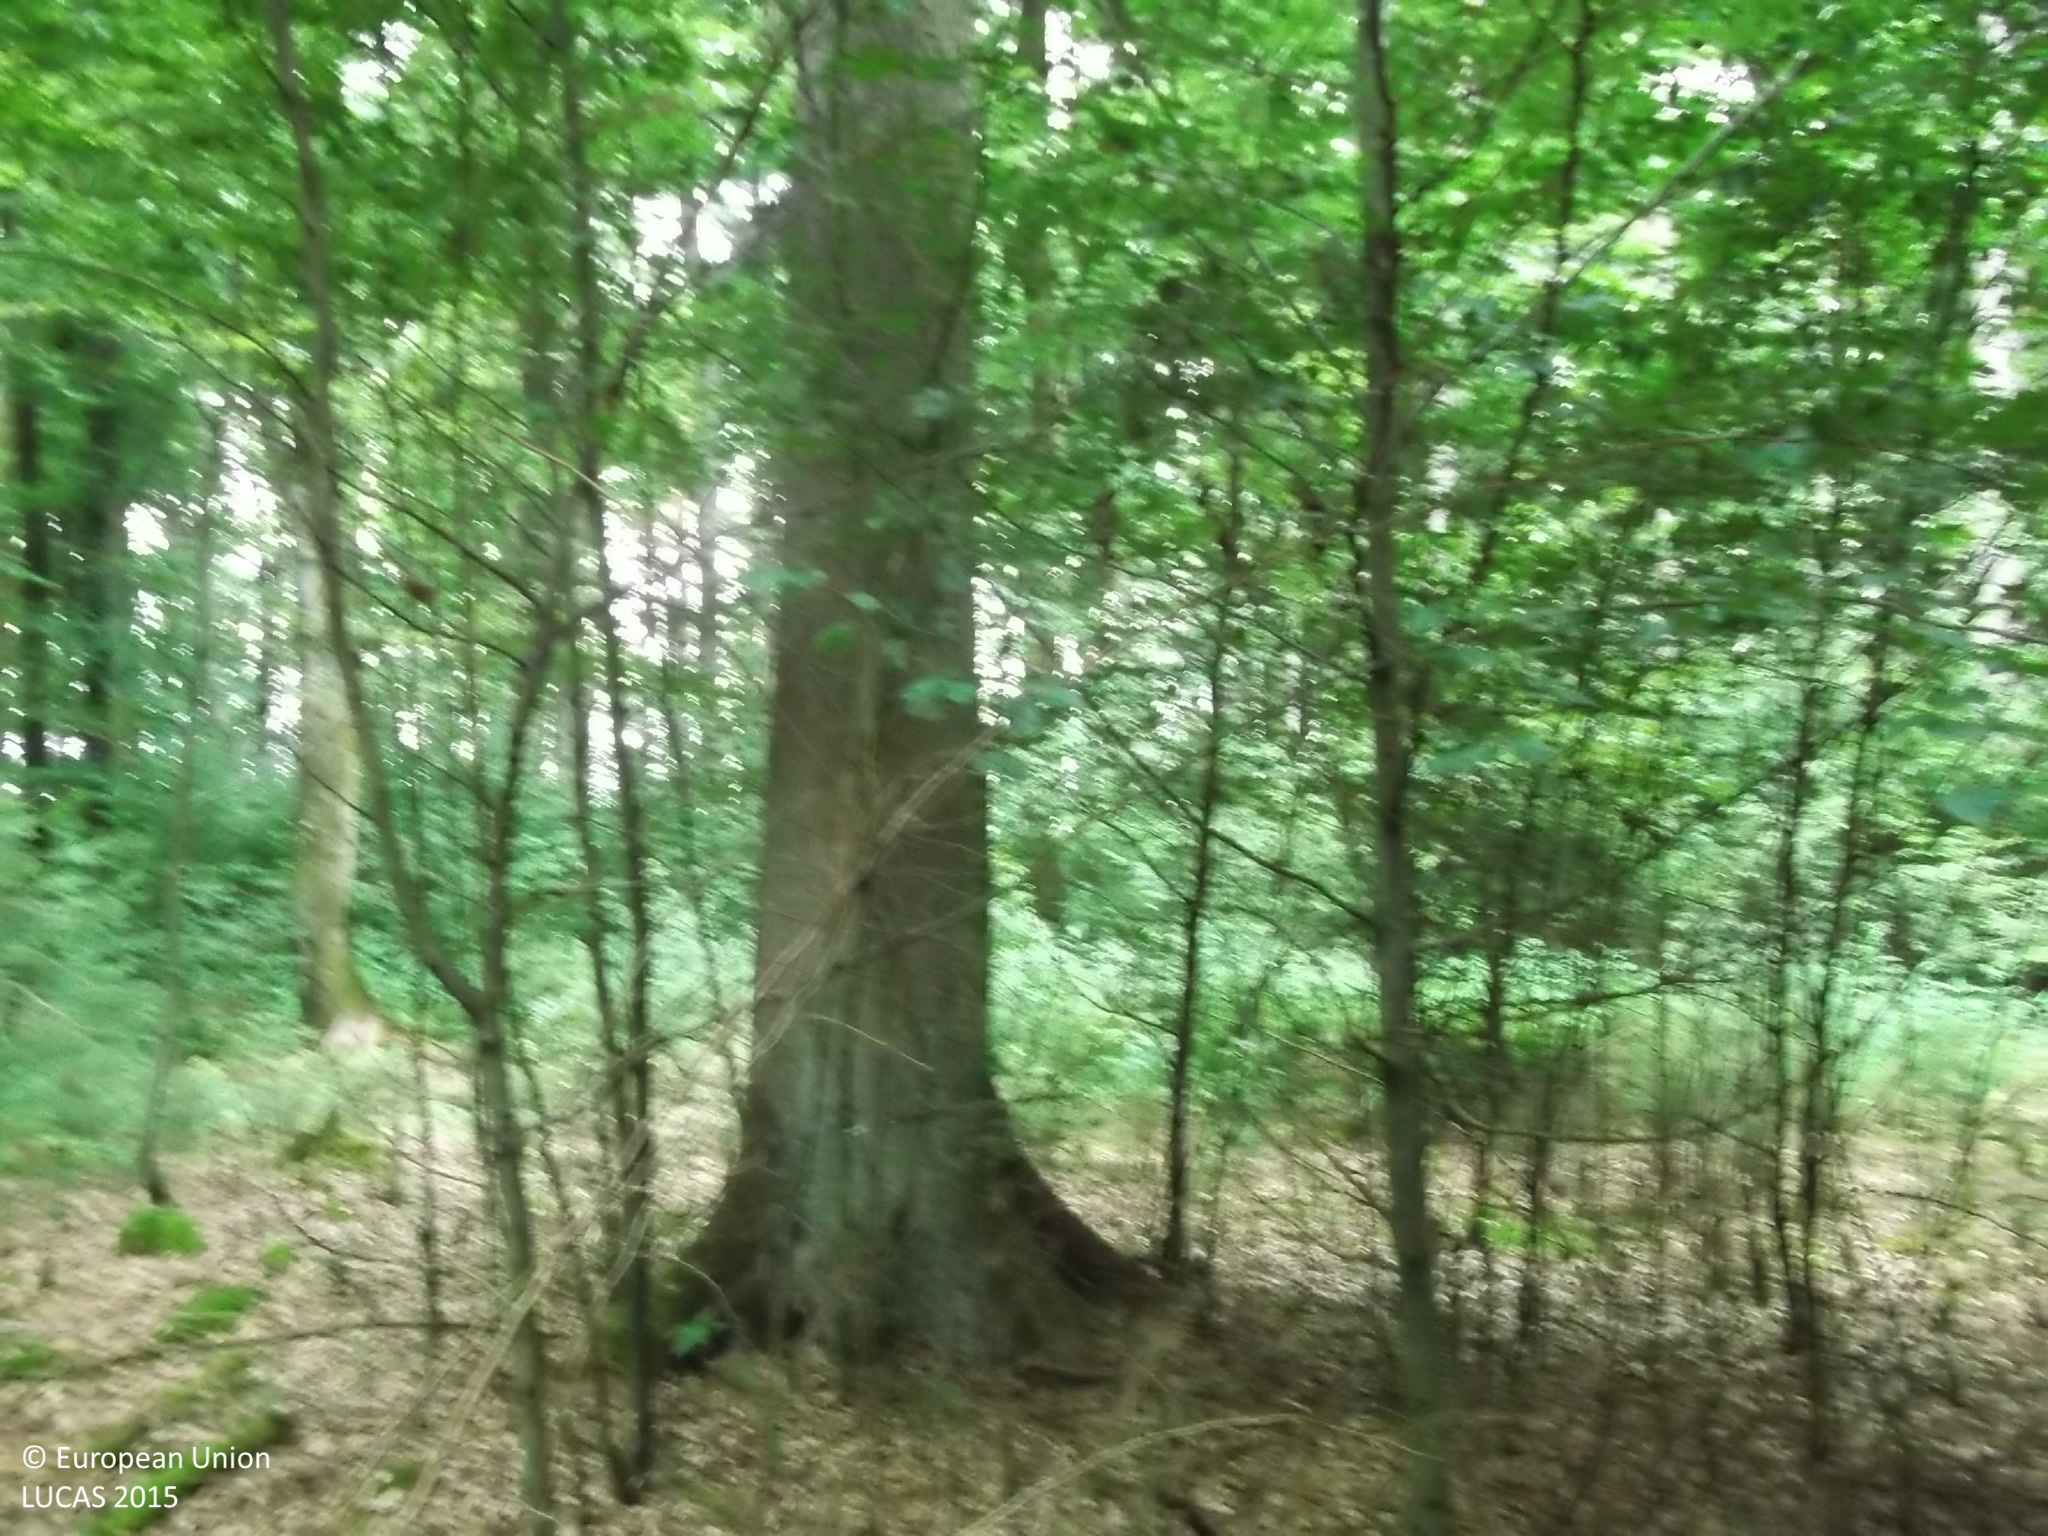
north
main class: Woodland
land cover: Spruce dominated mixed woodland
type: hemiboreal forest and nemoral coniferous forest and mixed broadleaved-coniferous forest
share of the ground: > 75 %
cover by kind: broadleaved forest trees 60 %, coniferous forest trees 40 %
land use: Forestry
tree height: > 5 m
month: July
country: AT
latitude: 48.1338
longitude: 12.8073
